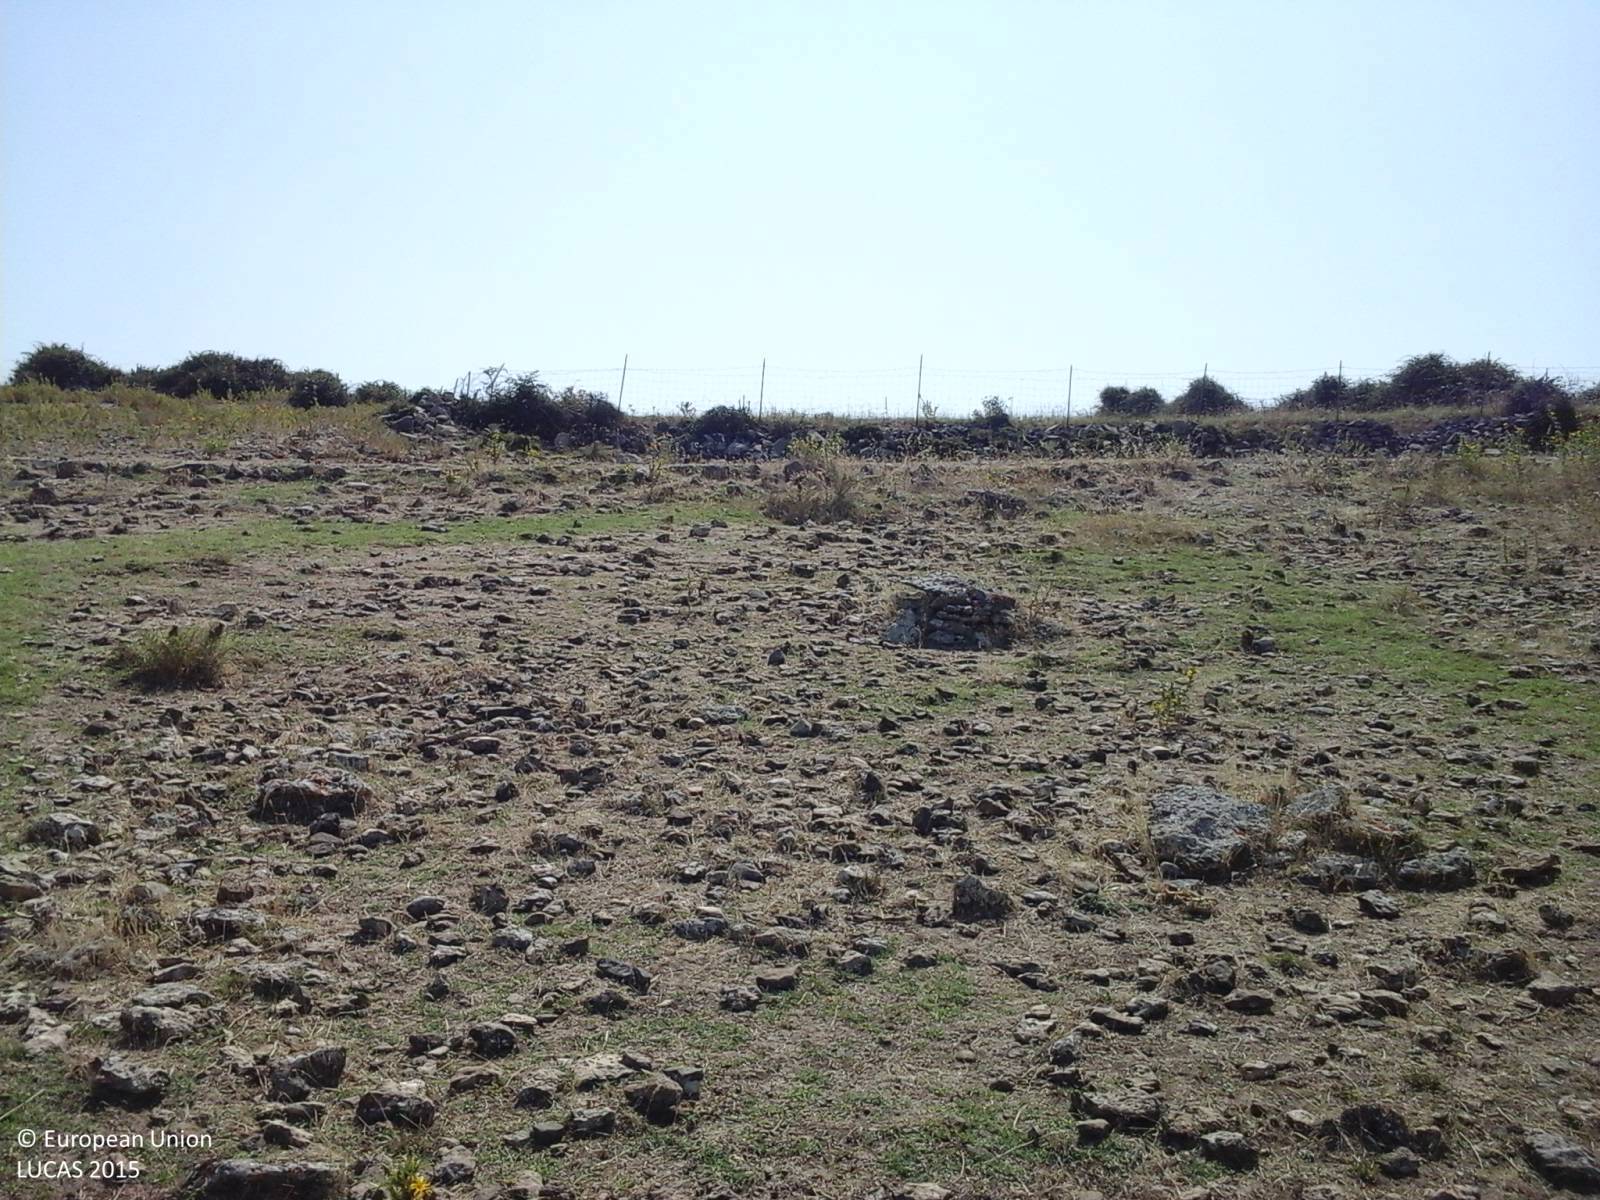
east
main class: Grassland
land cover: Grassland without tree/shrub cover
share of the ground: > 75 %
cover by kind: herbaceous plants 95 %, consolidated bare surface 5 %
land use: Agriculture (excluding fallow land and kitchen gardens)
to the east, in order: Grassland without tree/shrub cover; Grass margins; Tracks; Grassland without tree/shrub cover; Abandoned hedges; Fences; Dry stone walls; Grassland without tree/shrub cover; Dry stone walls; Fences; Grassland without tree/shrub cover
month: July
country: IT
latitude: 40.4222
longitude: 8.7453
